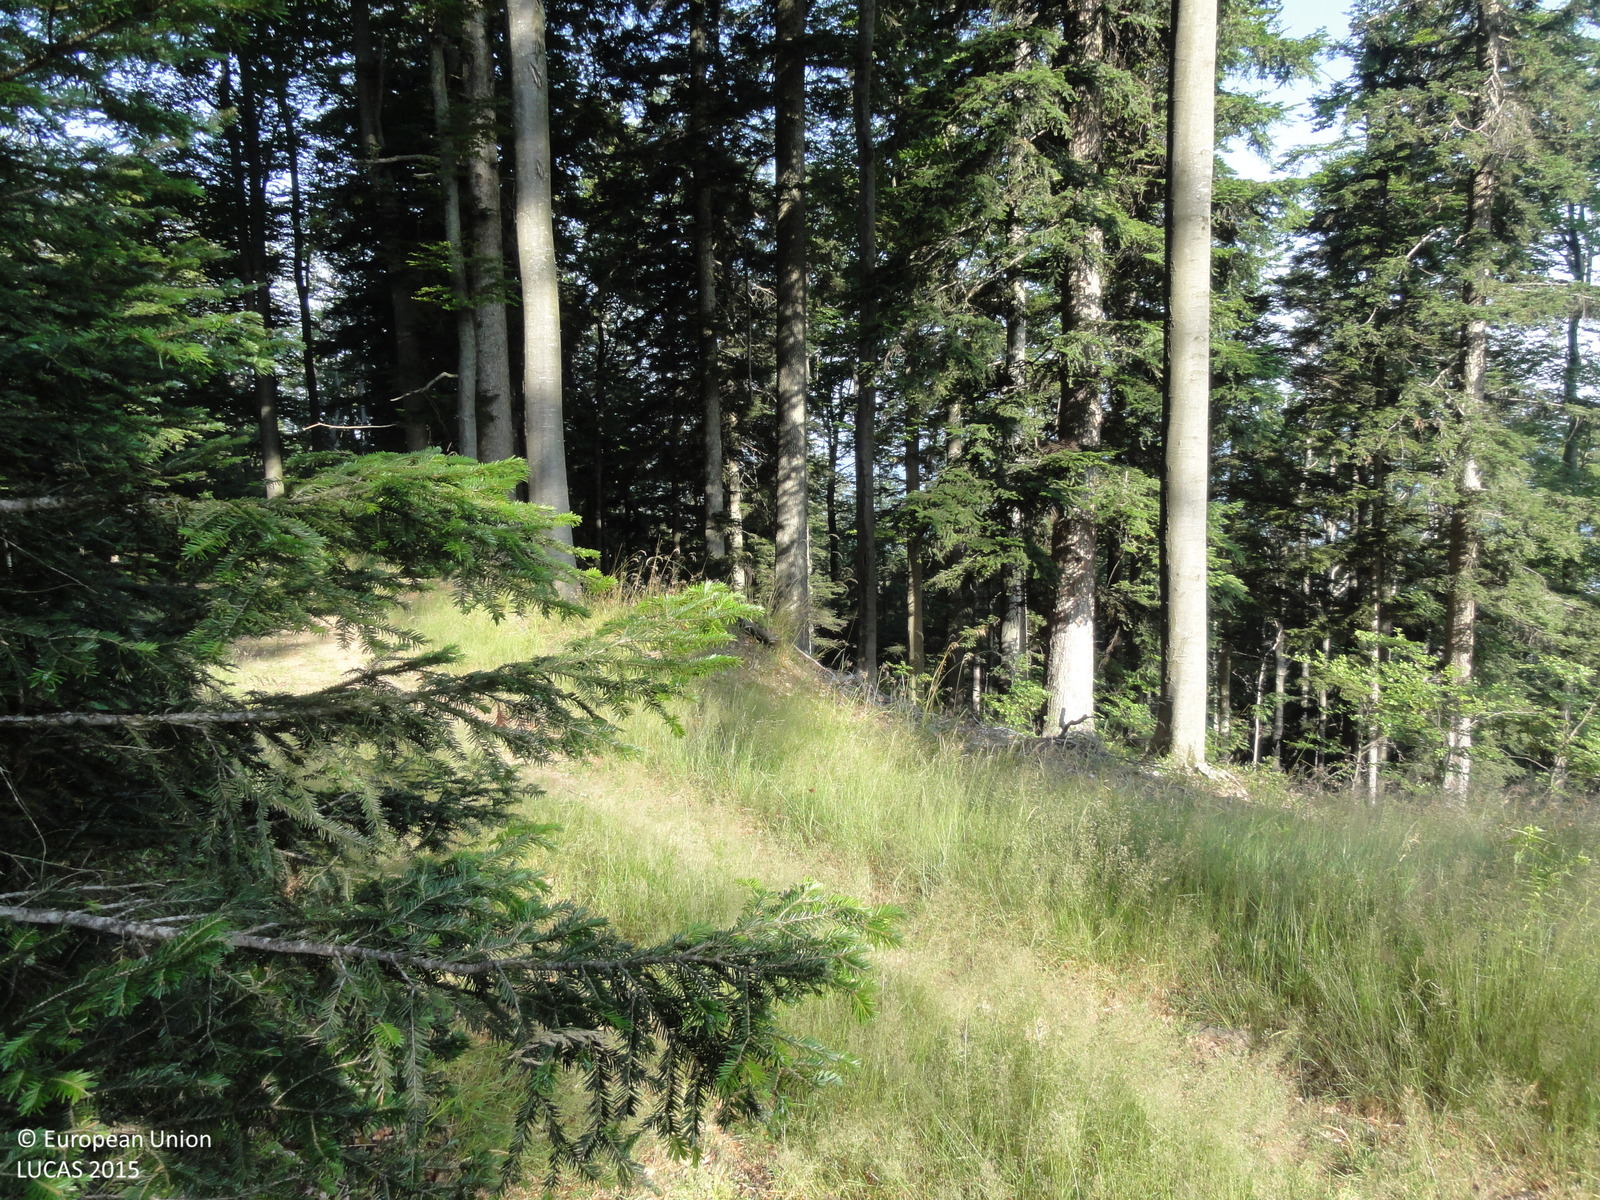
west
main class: Woodland
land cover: Spruce dominated mixed woodland
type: mountainous beech forest
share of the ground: > 75 %
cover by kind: coniferous forest trees 50 %, broadleaved forest trees 30 %, herbaceous plants 20 %
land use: Forestry
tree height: > 5 m
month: July
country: SI
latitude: 46.5133
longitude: 15.5641
